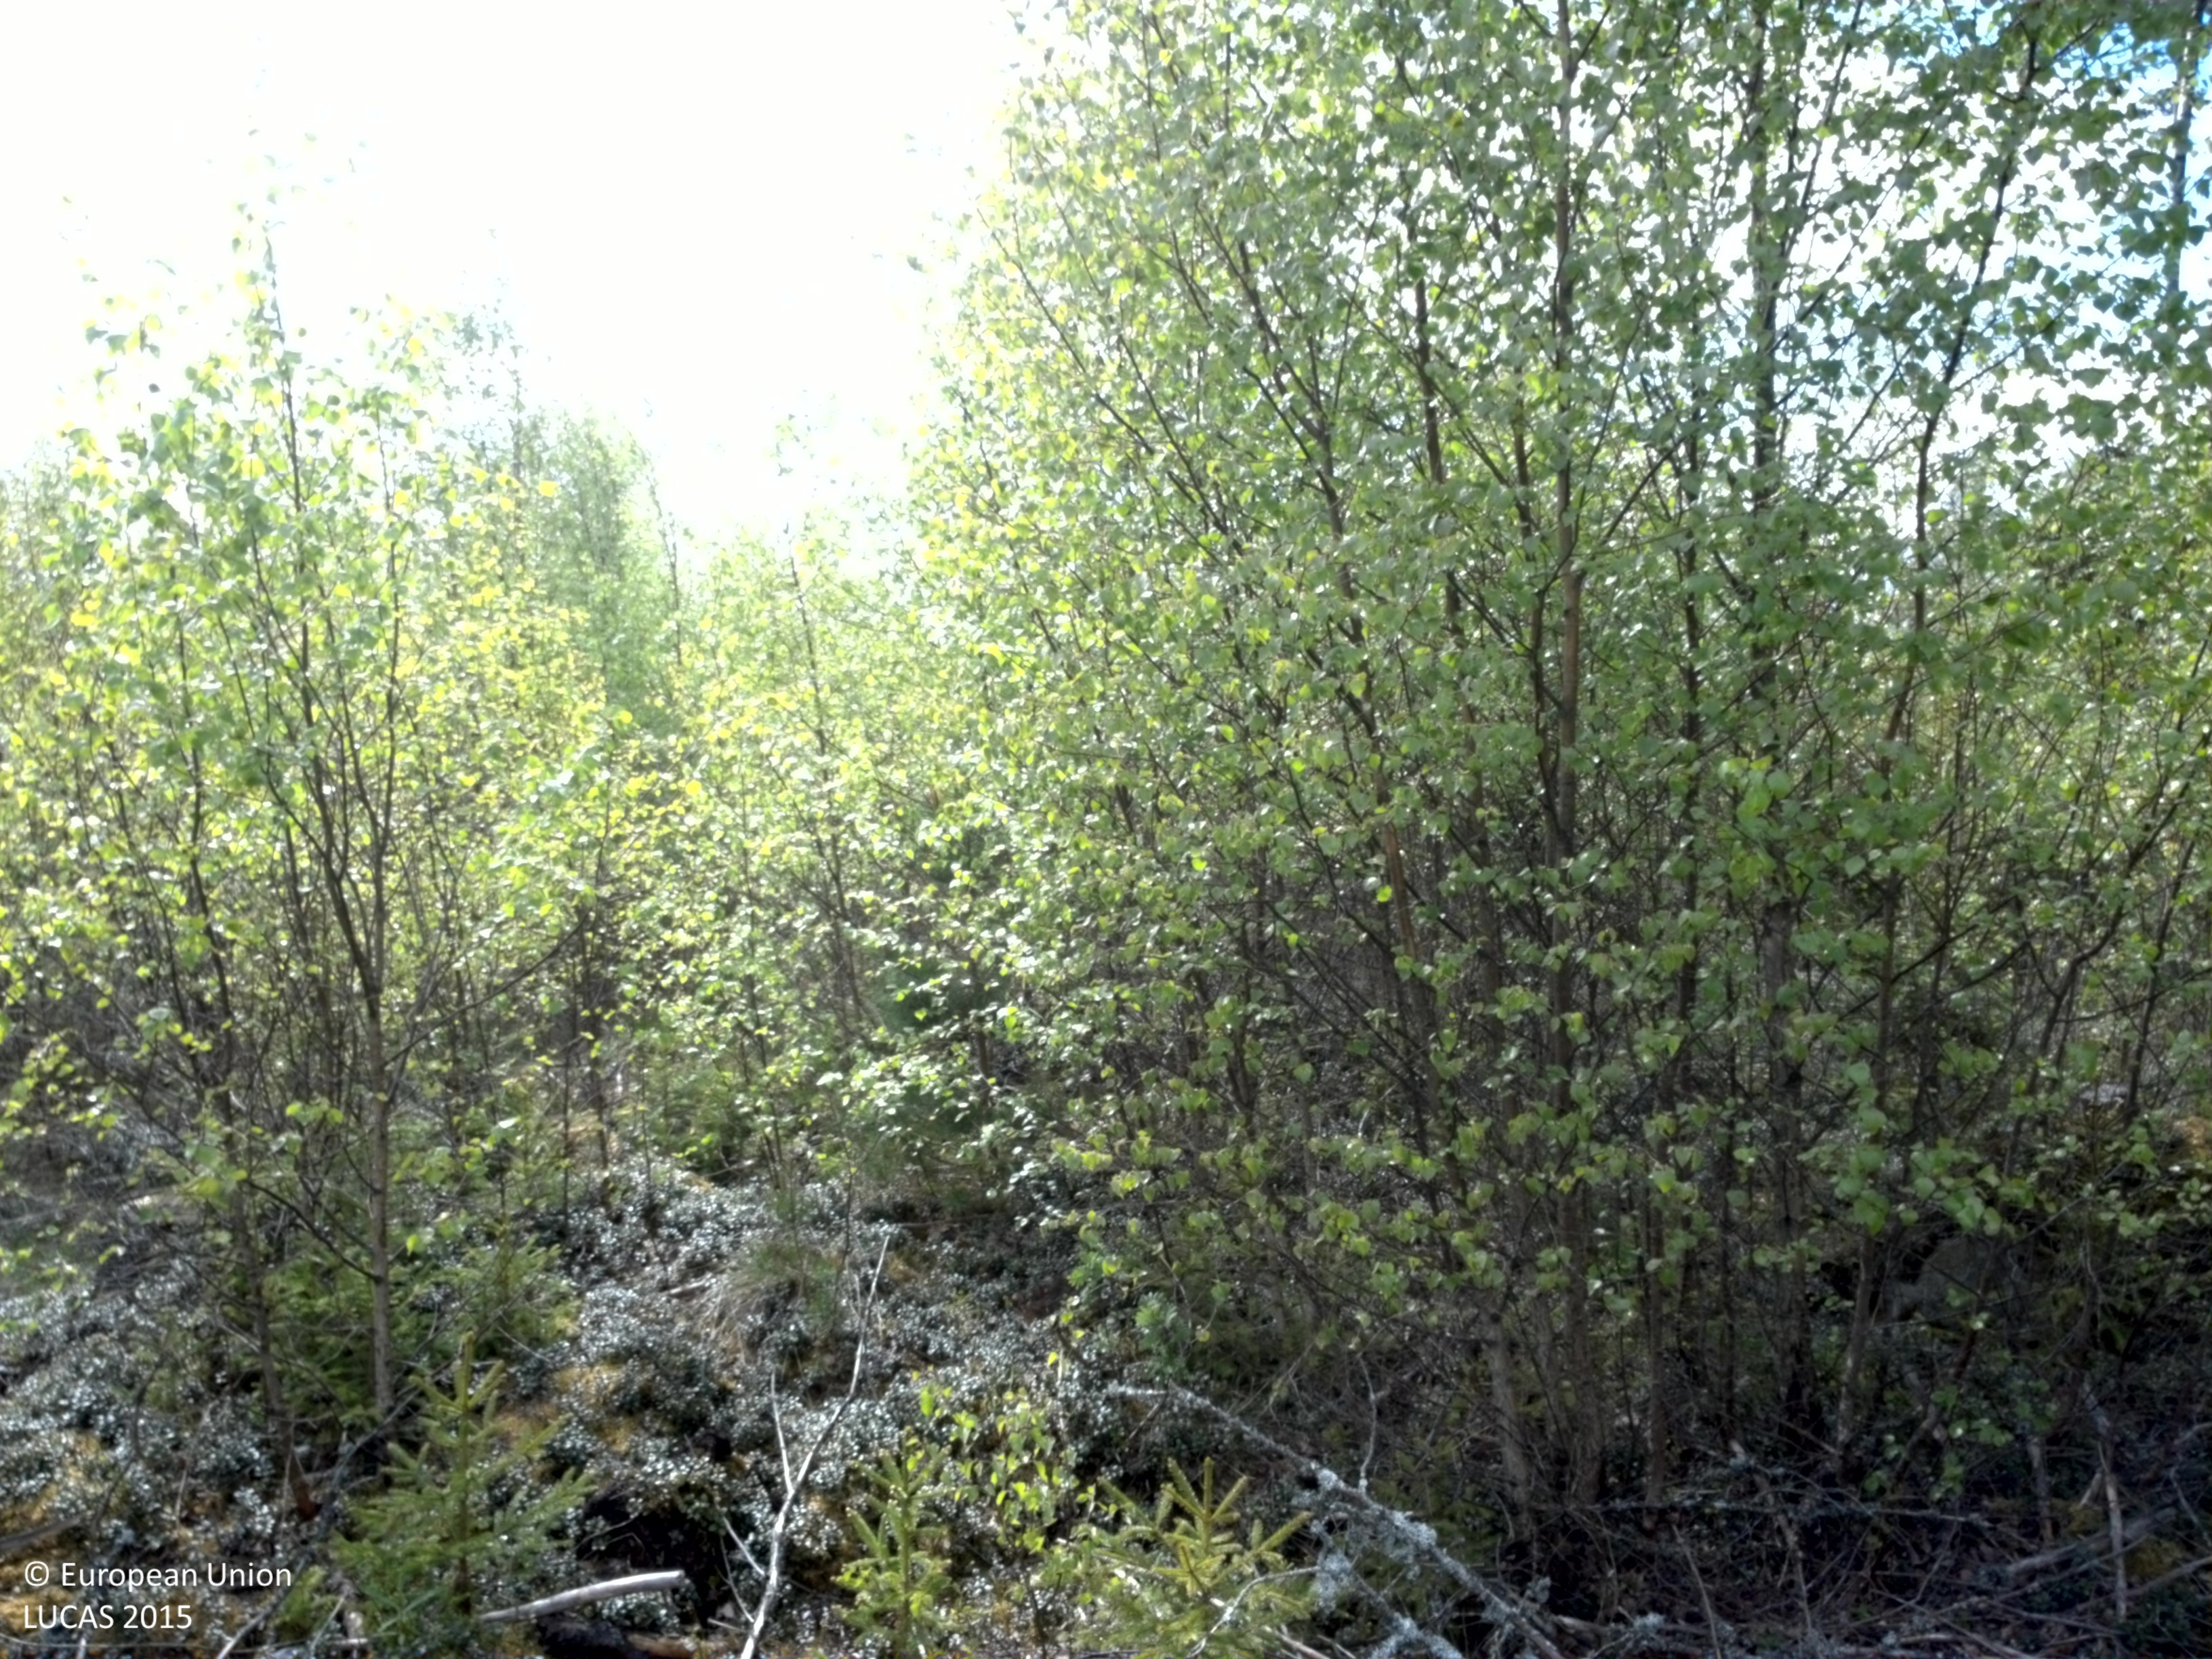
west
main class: Woodland
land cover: Broadleaved woodland
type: boreal forest
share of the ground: > 75 %
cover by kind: broadleaved forest trees 80 %, coniferous forest trees 10 %, lichens and mosses 10 %
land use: Forestry
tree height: < 5 m
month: May
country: SE
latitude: 56.6868
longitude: 14.4540
